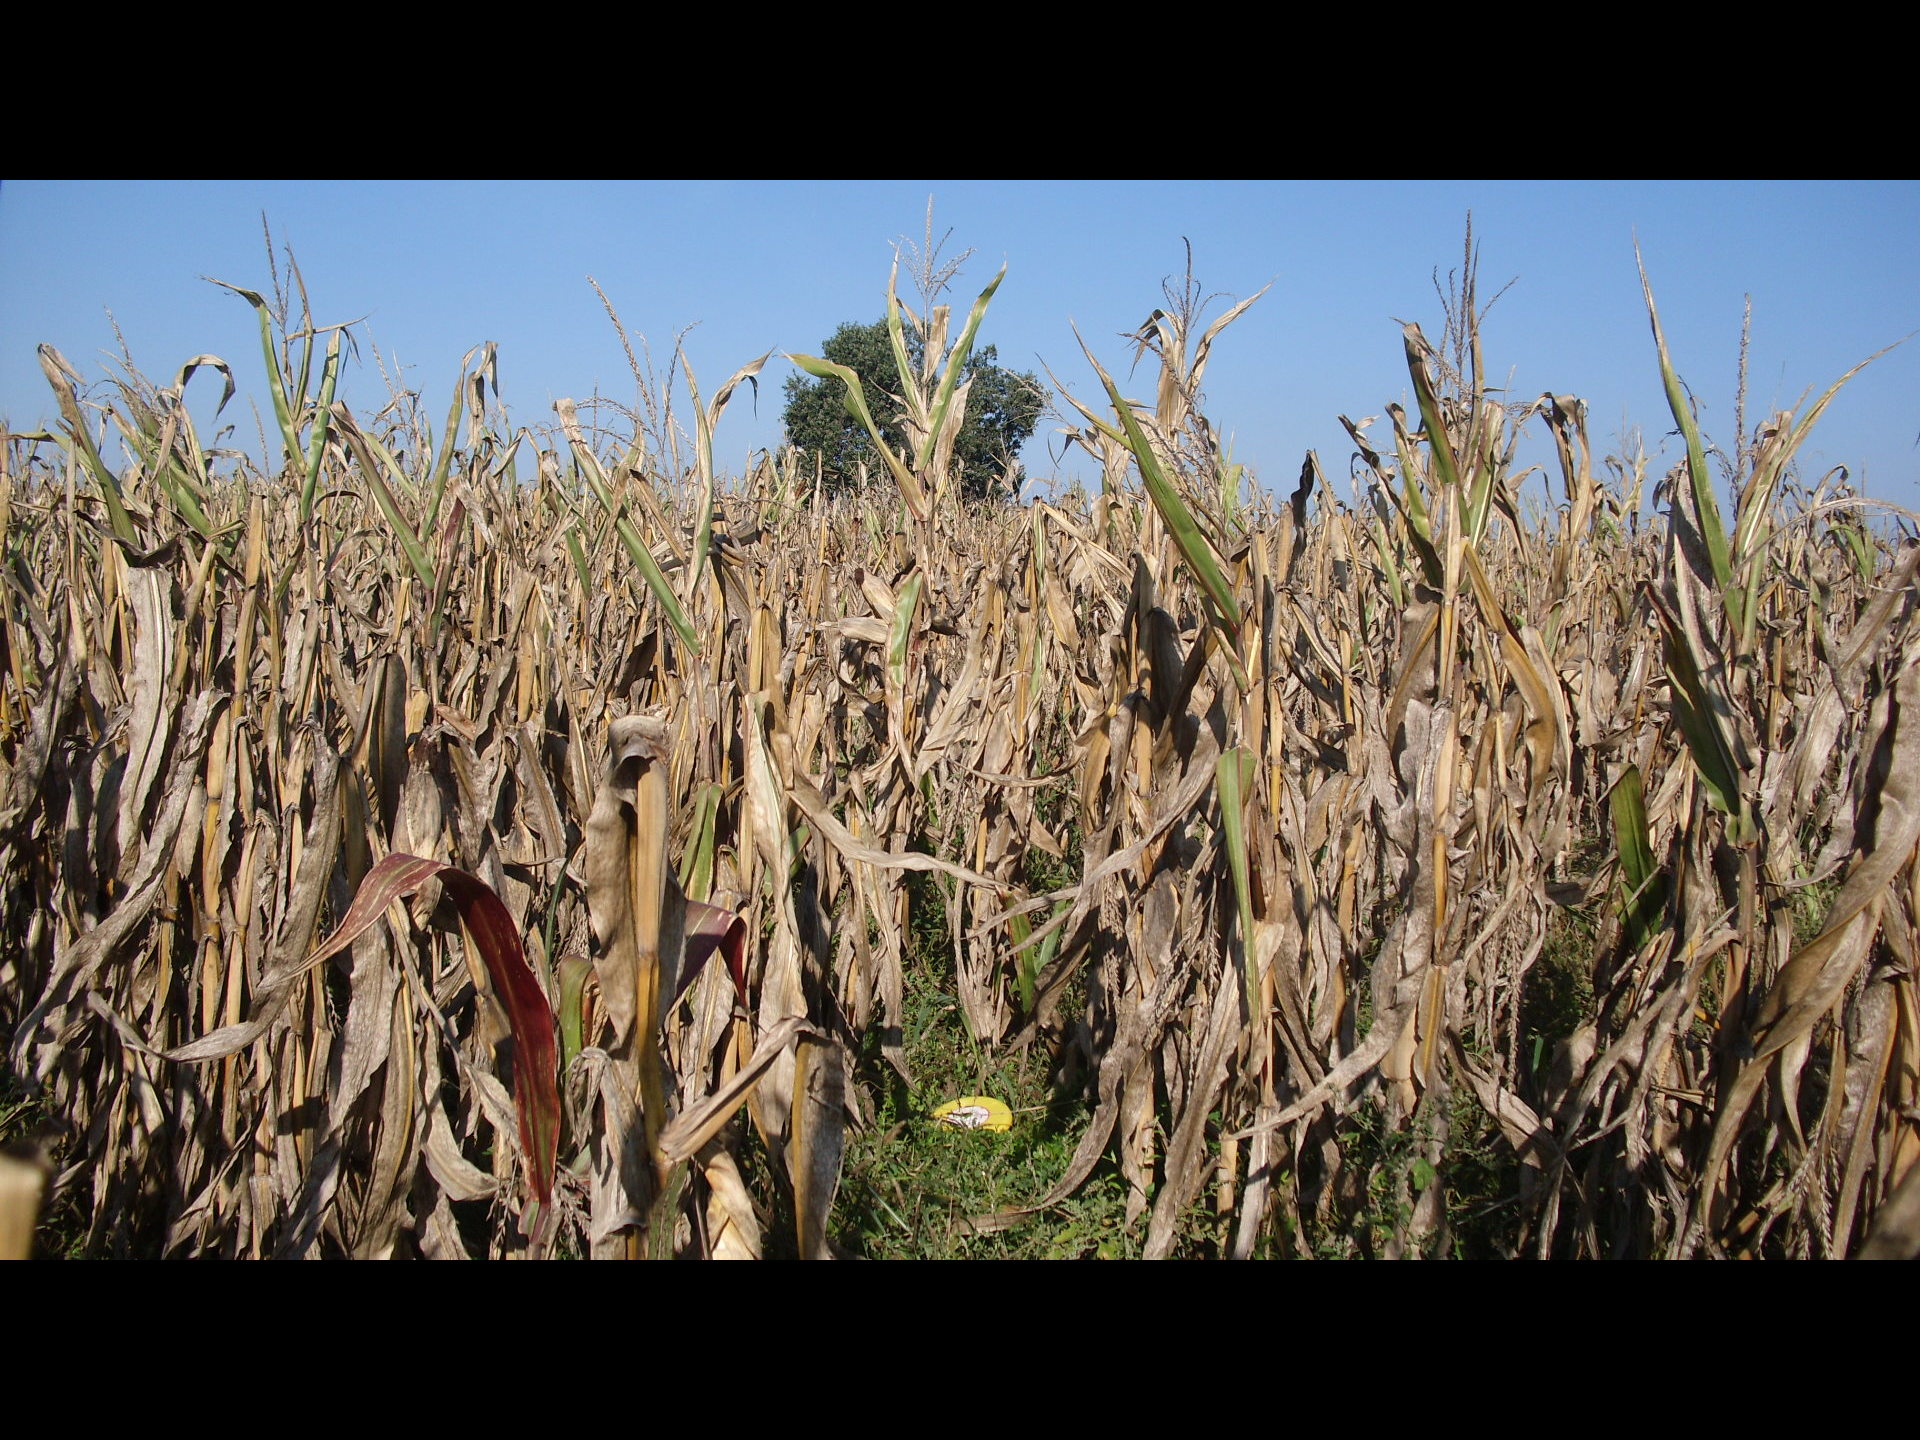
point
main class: Cropland
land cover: Maize
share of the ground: > 75 %
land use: Agriculture (excluding fallow land and kitchen gardens)
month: October
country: BG
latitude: 43.8092
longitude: 22.8038
